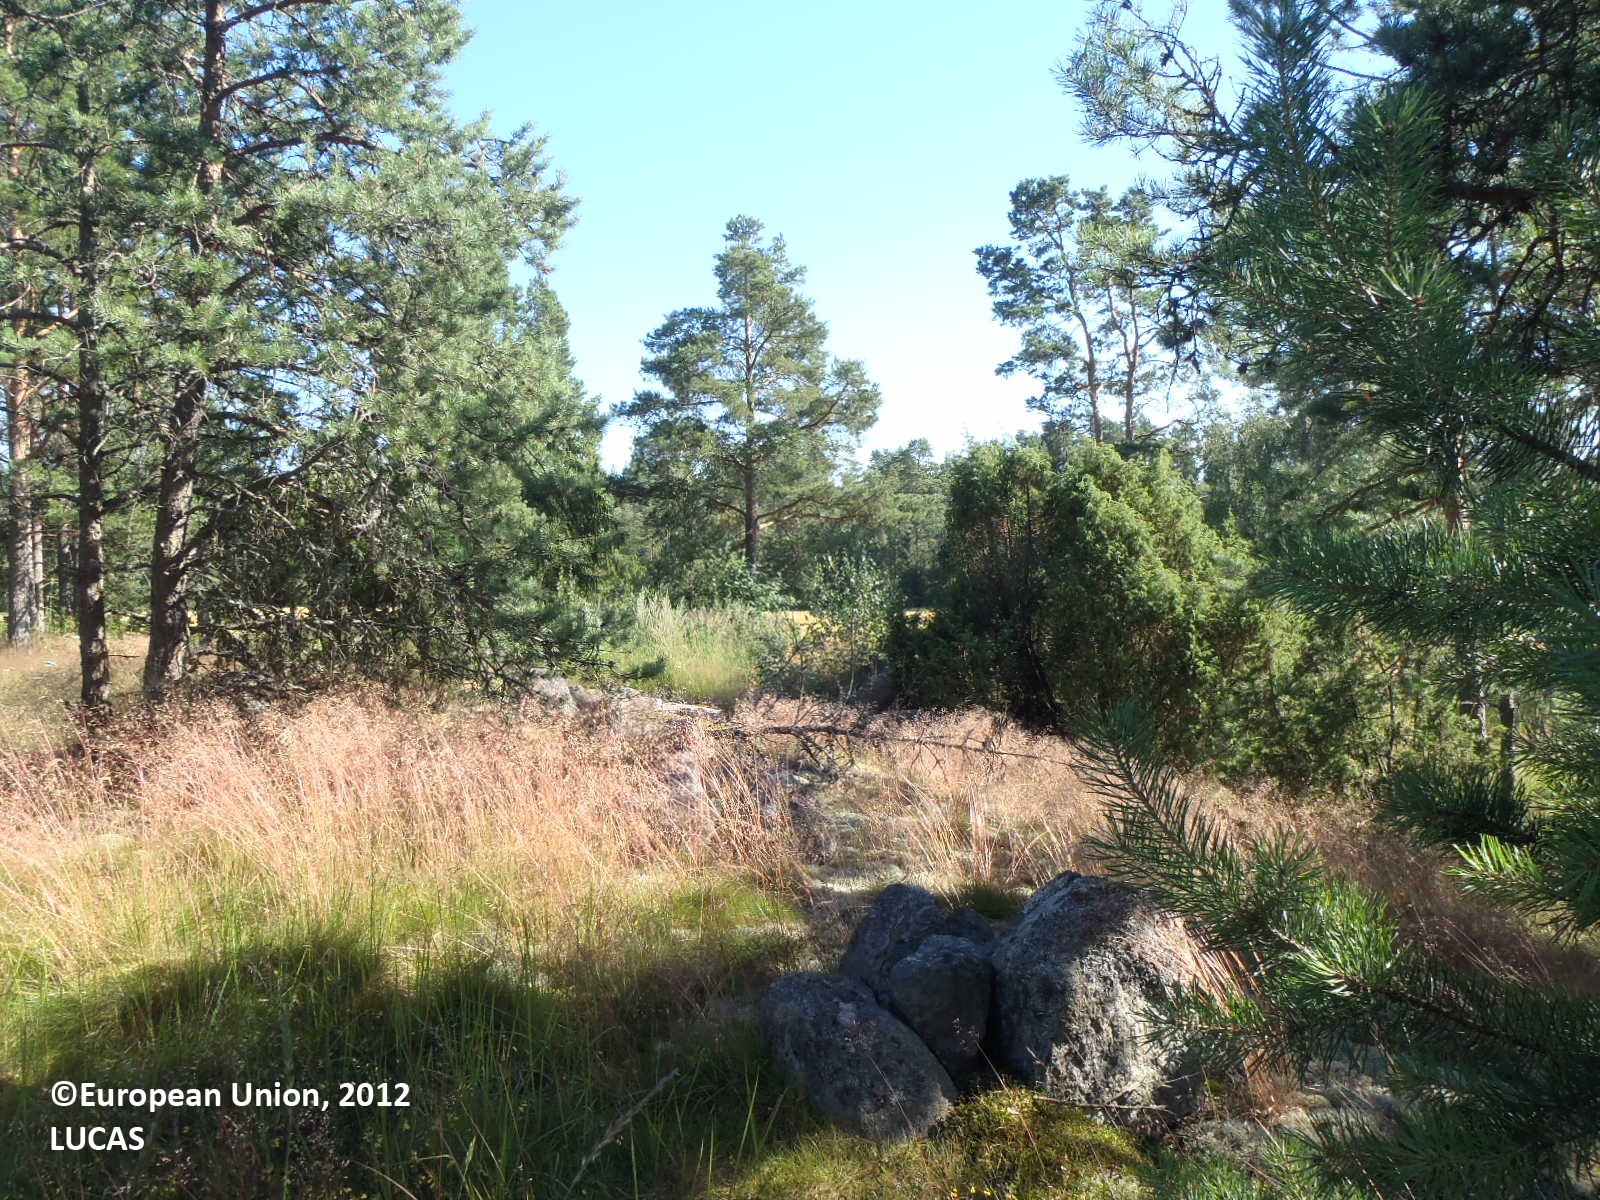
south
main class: Woodland
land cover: Pine dominated coniferous woodland
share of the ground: 25 - 50 %
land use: Forestry
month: July
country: FI
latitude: 60.6572
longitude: 21.7117
